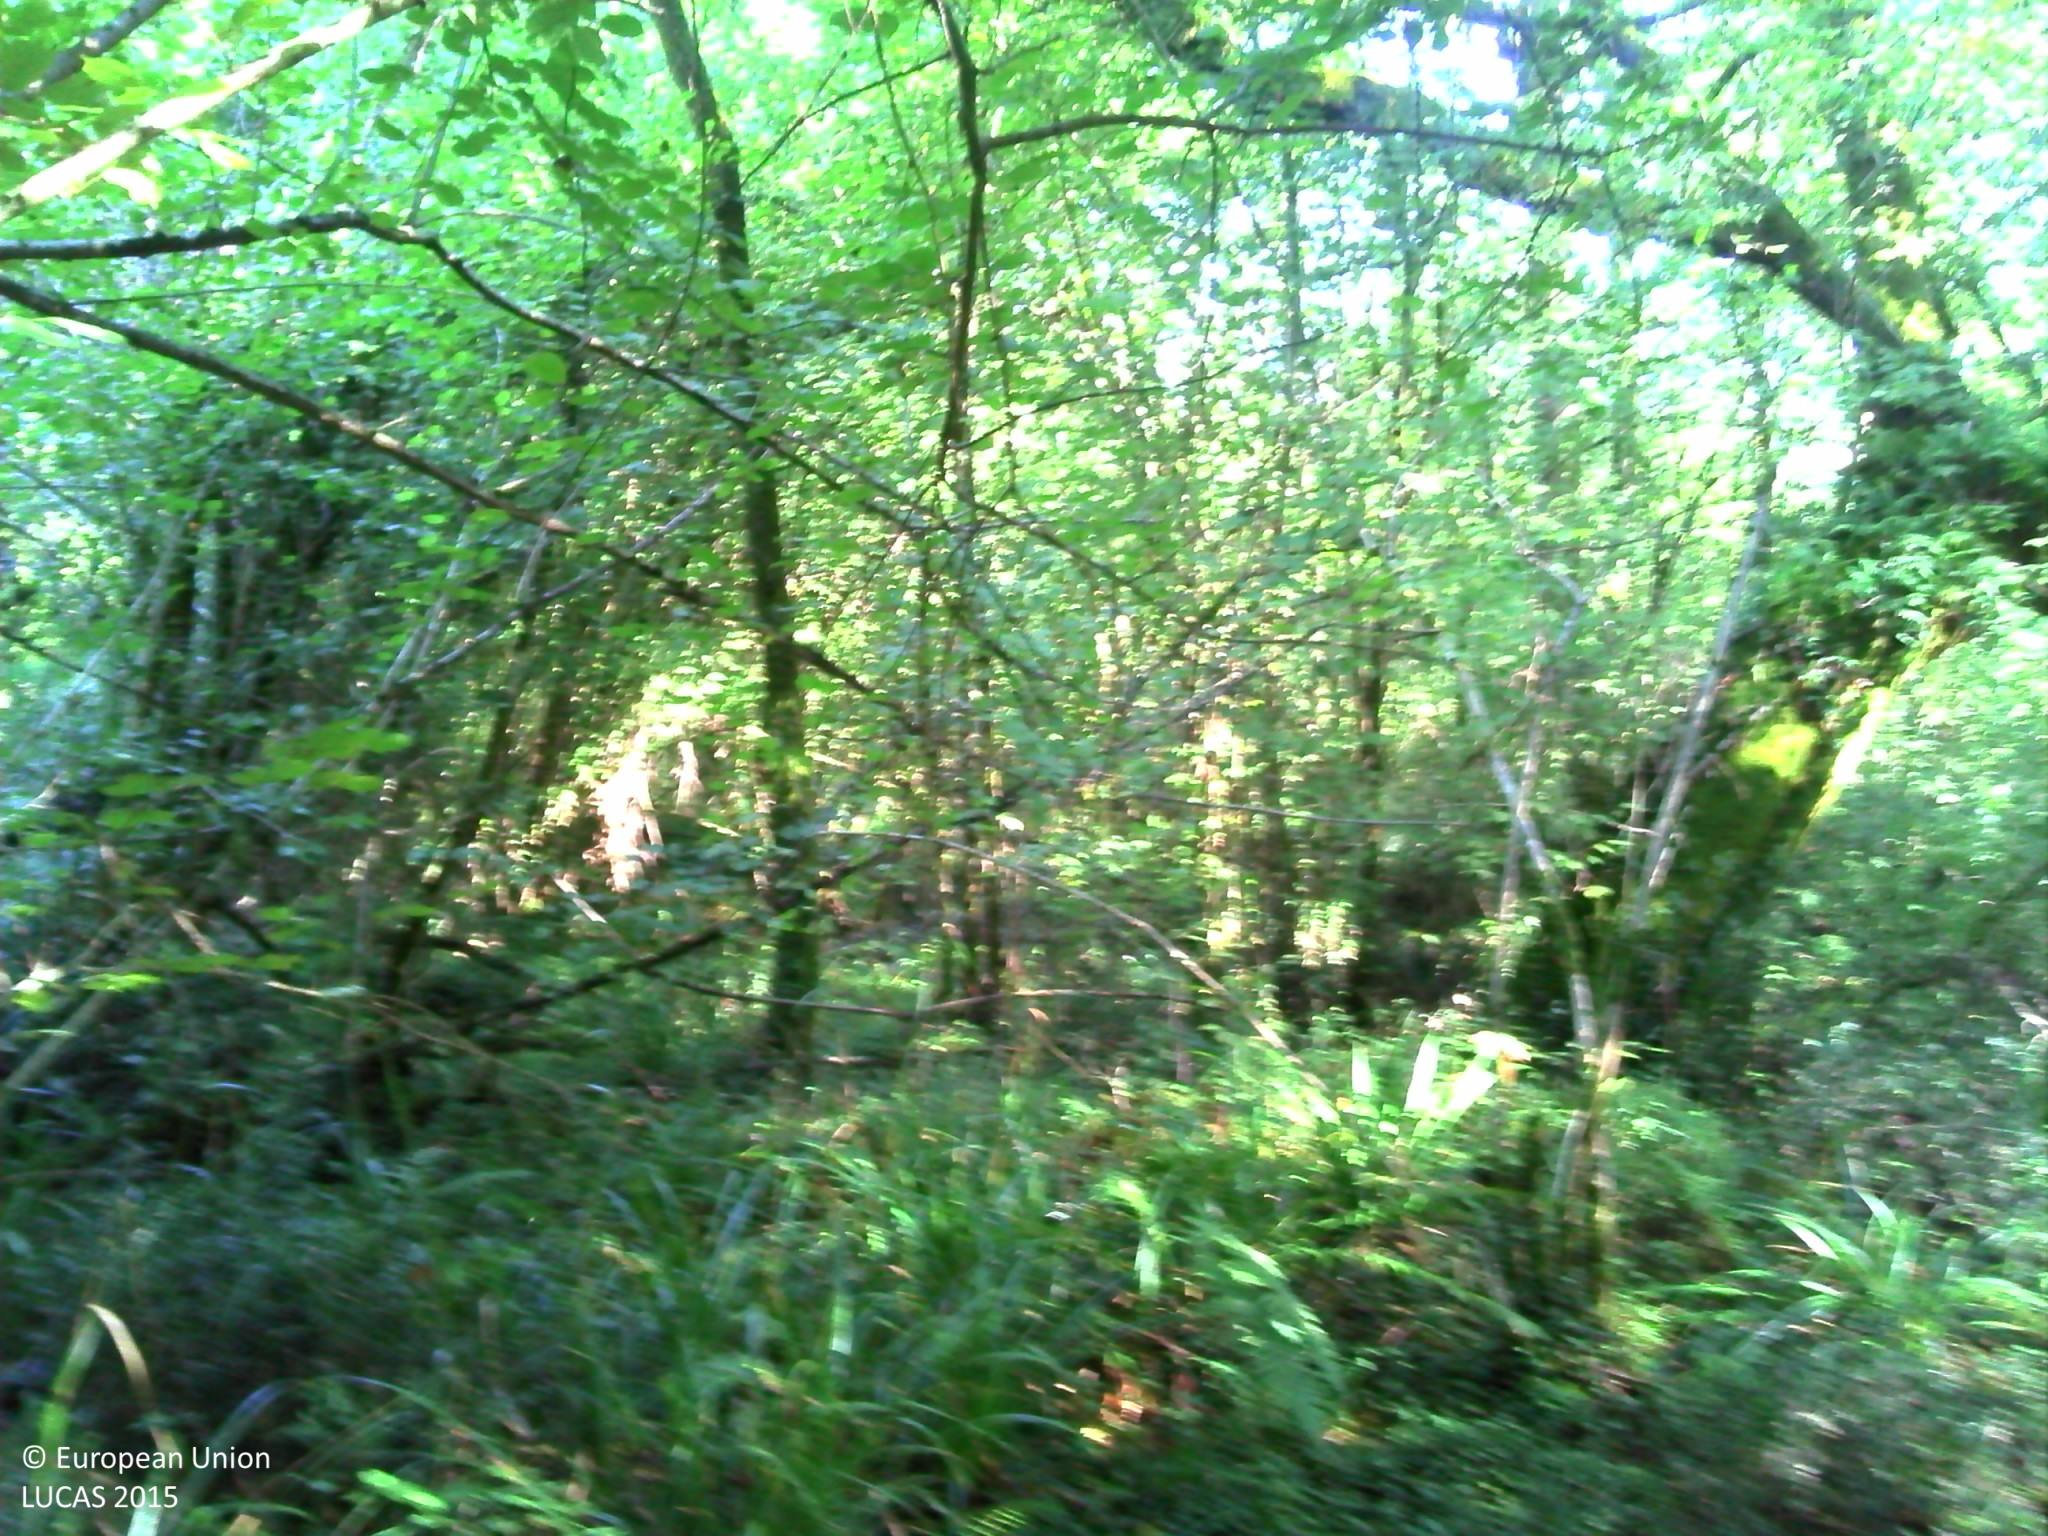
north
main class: Woodland
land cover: Broadleaved woodland
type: mesophytic deciduous forest
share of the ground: > 75 %
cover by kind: broadleaved forest trees 80 %, lichens and mosses 10 %, shrubs 5 %, herbaceous plants 5 %
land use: Forestry
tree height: > 5 m
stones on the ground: < 10 %
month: September
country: FR
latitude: 43.4629
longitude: -0.7519
